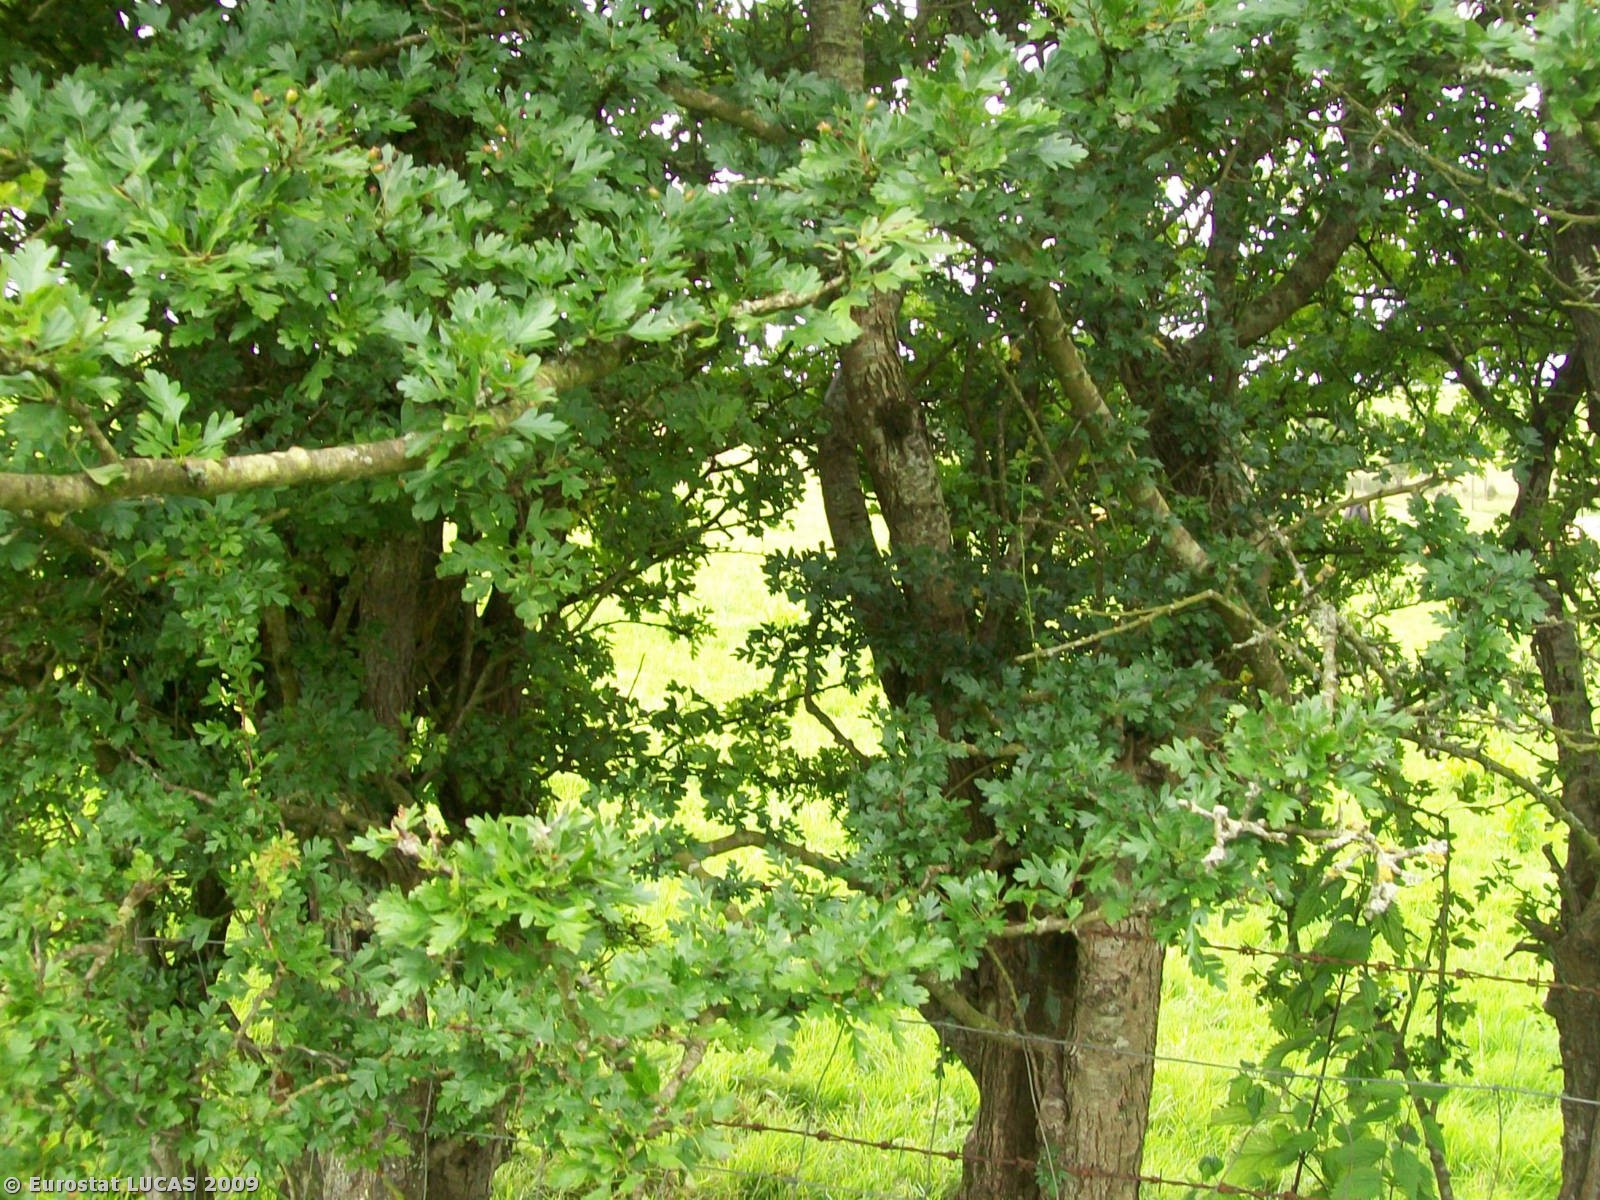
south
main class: Grassland
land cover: Grassland without tree/shrub cover
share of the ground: > 75 %
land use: Agriculture (excluding fallow land and kitchen gardens)
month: July
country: GB
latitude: 55.1712
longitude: -6.3028
